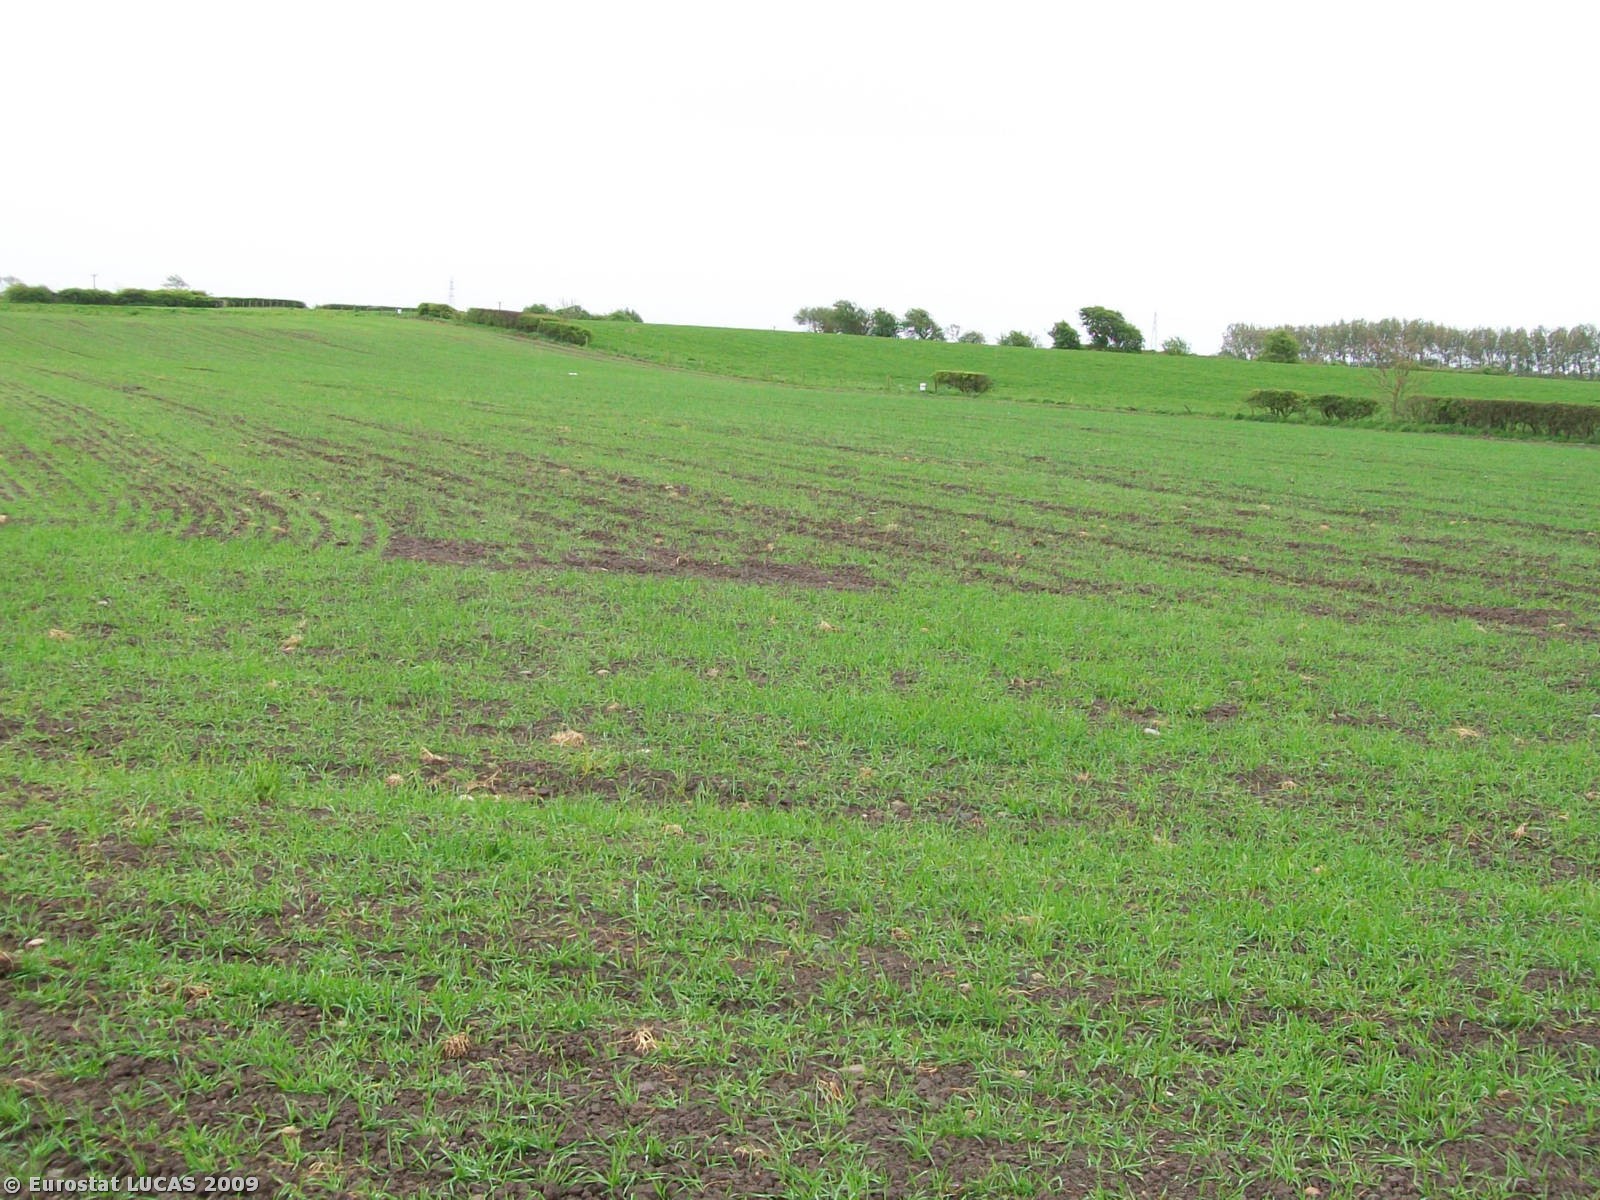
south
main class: Cropland
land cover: Barley
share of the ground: < 10 %
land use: Agriculture (excluding fallow land and kitchen gardens)
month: May
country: GB
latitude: 53.7660
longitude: -2.8910
